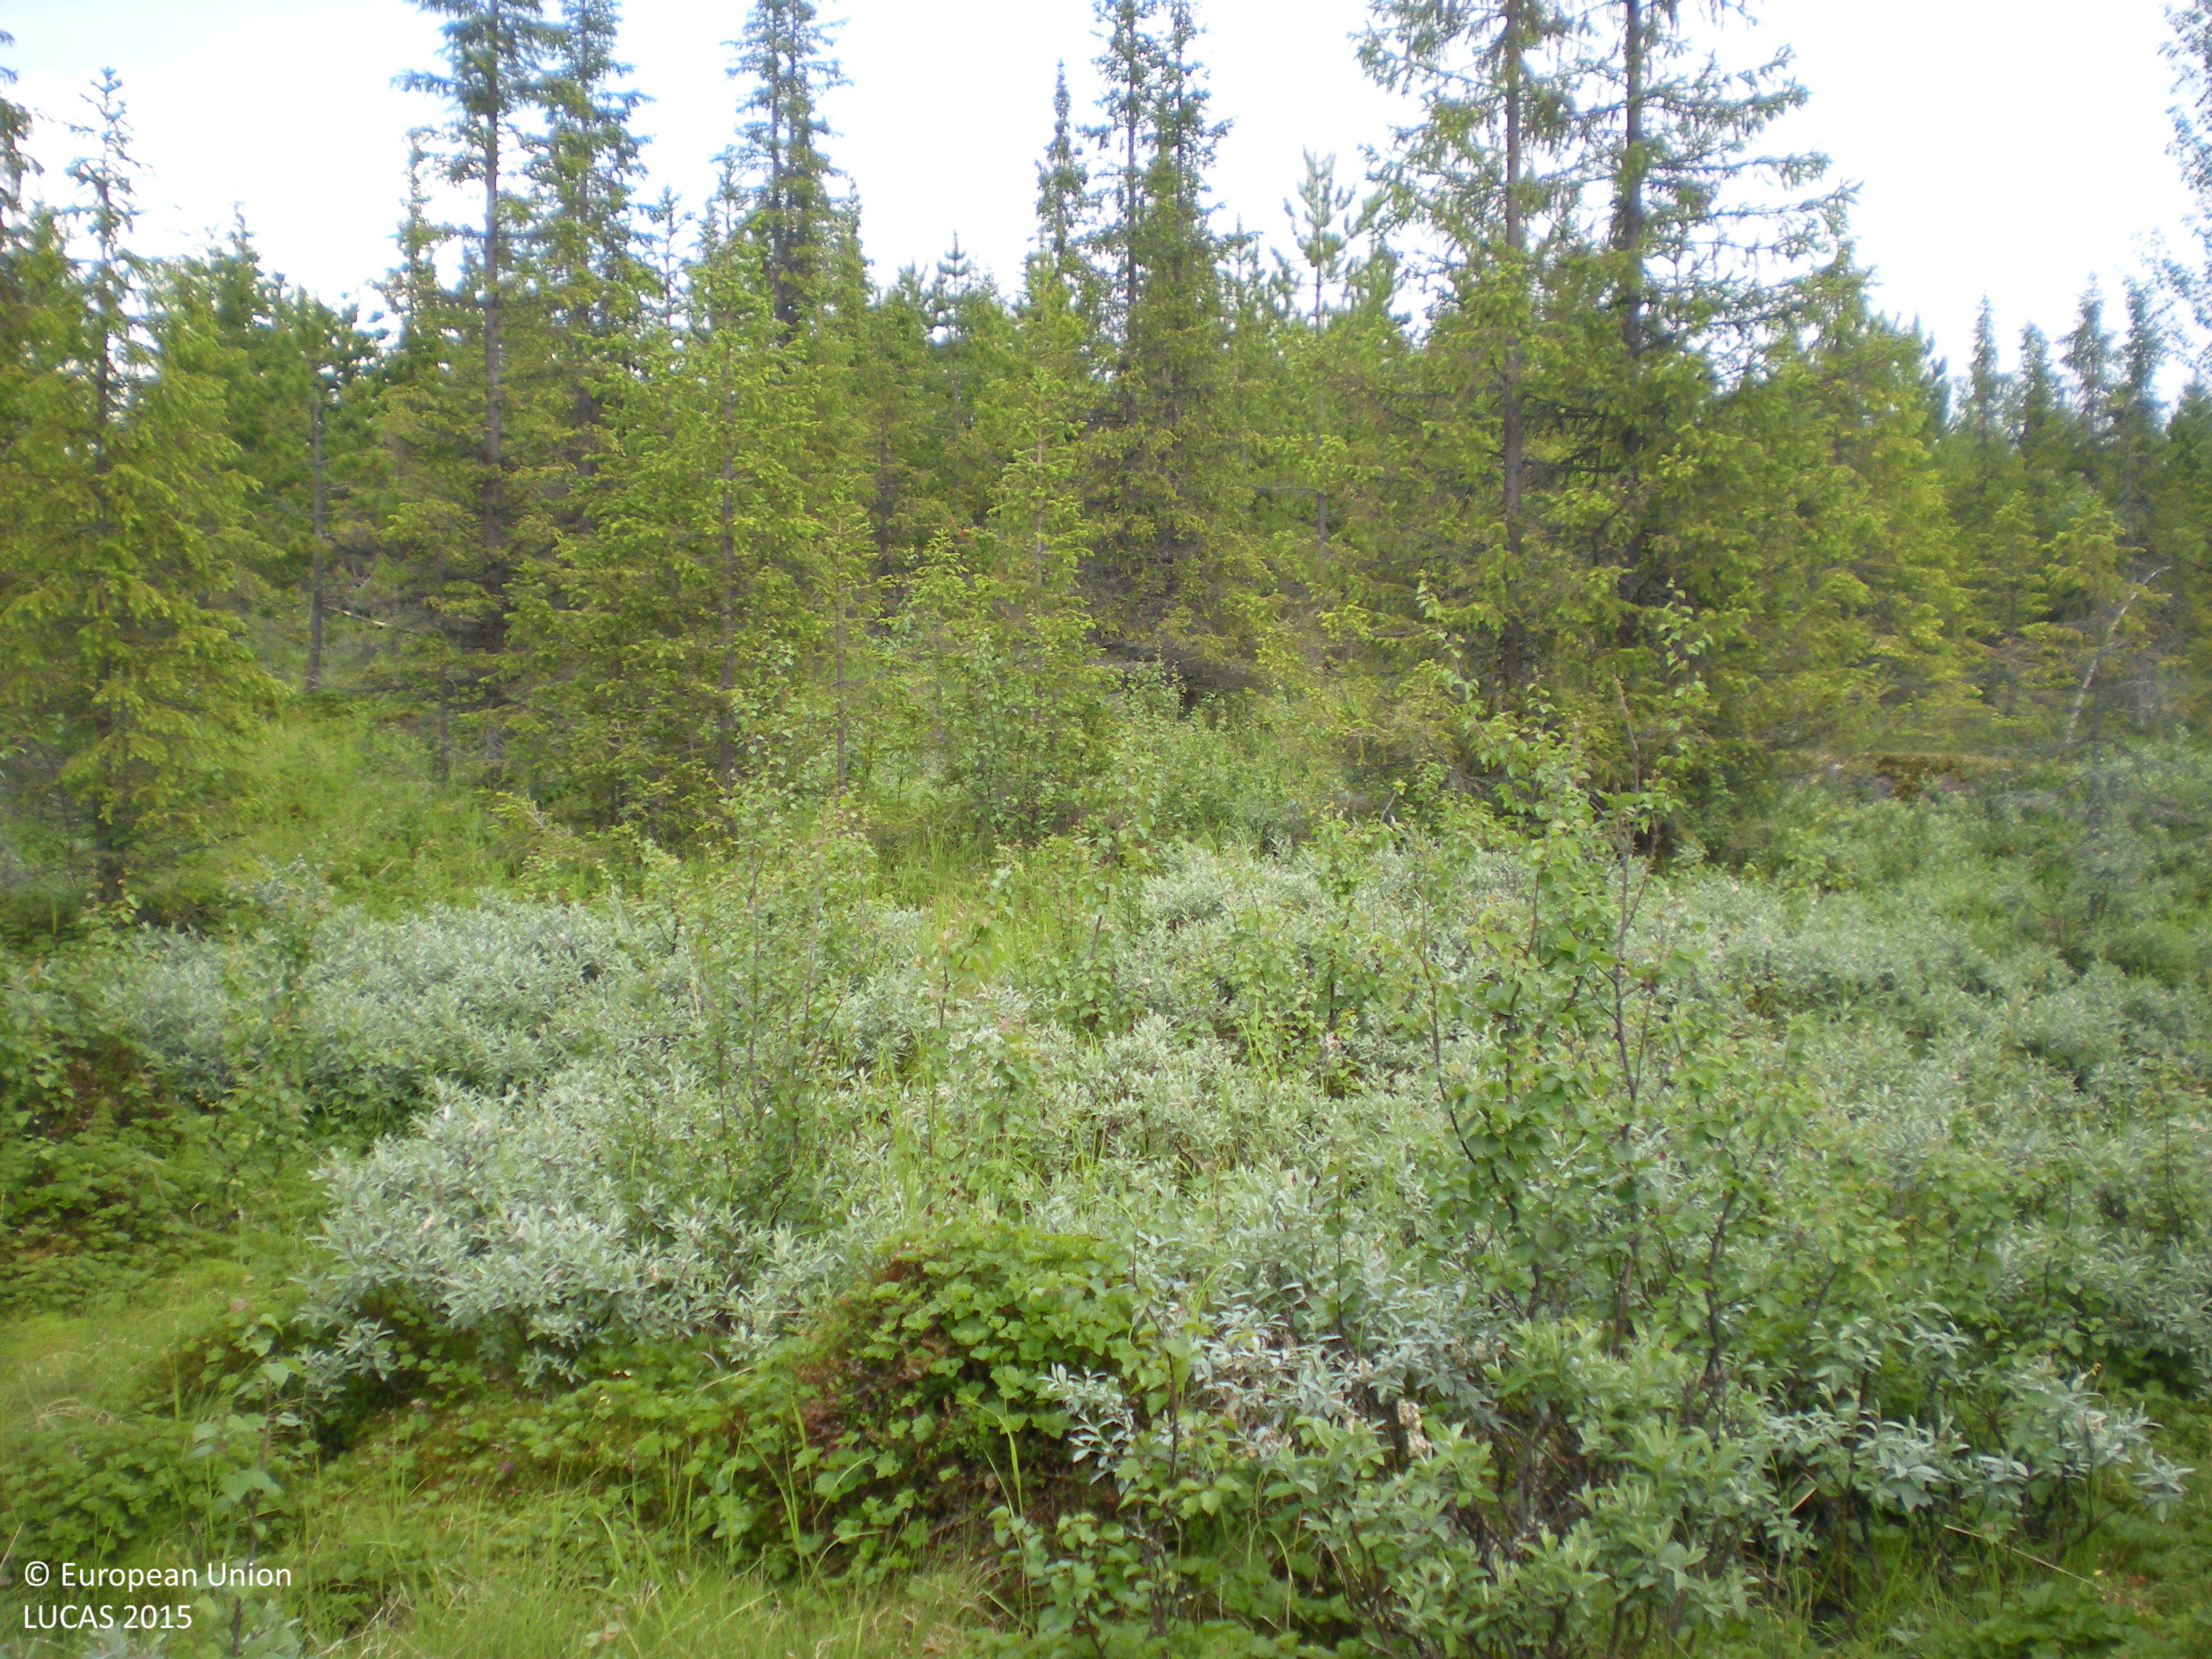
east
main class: Woodland
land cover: Spruce dominated mixed woodland
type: boreal forest
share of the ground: 50 - 75 %
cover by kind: coniferous forest trees 30 %, broadleaved forest trees 20 %, shrubs 20 %, herbaceous plants 20 %, lichens and mosses 10 %
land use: Forestry
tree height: > 5 m
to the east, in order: Spruce dominated mixed woodland; Other coniferous woodland; Paved roads, cycling and walking lanes; Other coniferous woodland; Spruce dominated mixed woodland; Rocks and stones; Spruce dominated mixed woodland; Peatbogs
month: July
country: SE
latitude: 65.9182
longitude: 17.3144
